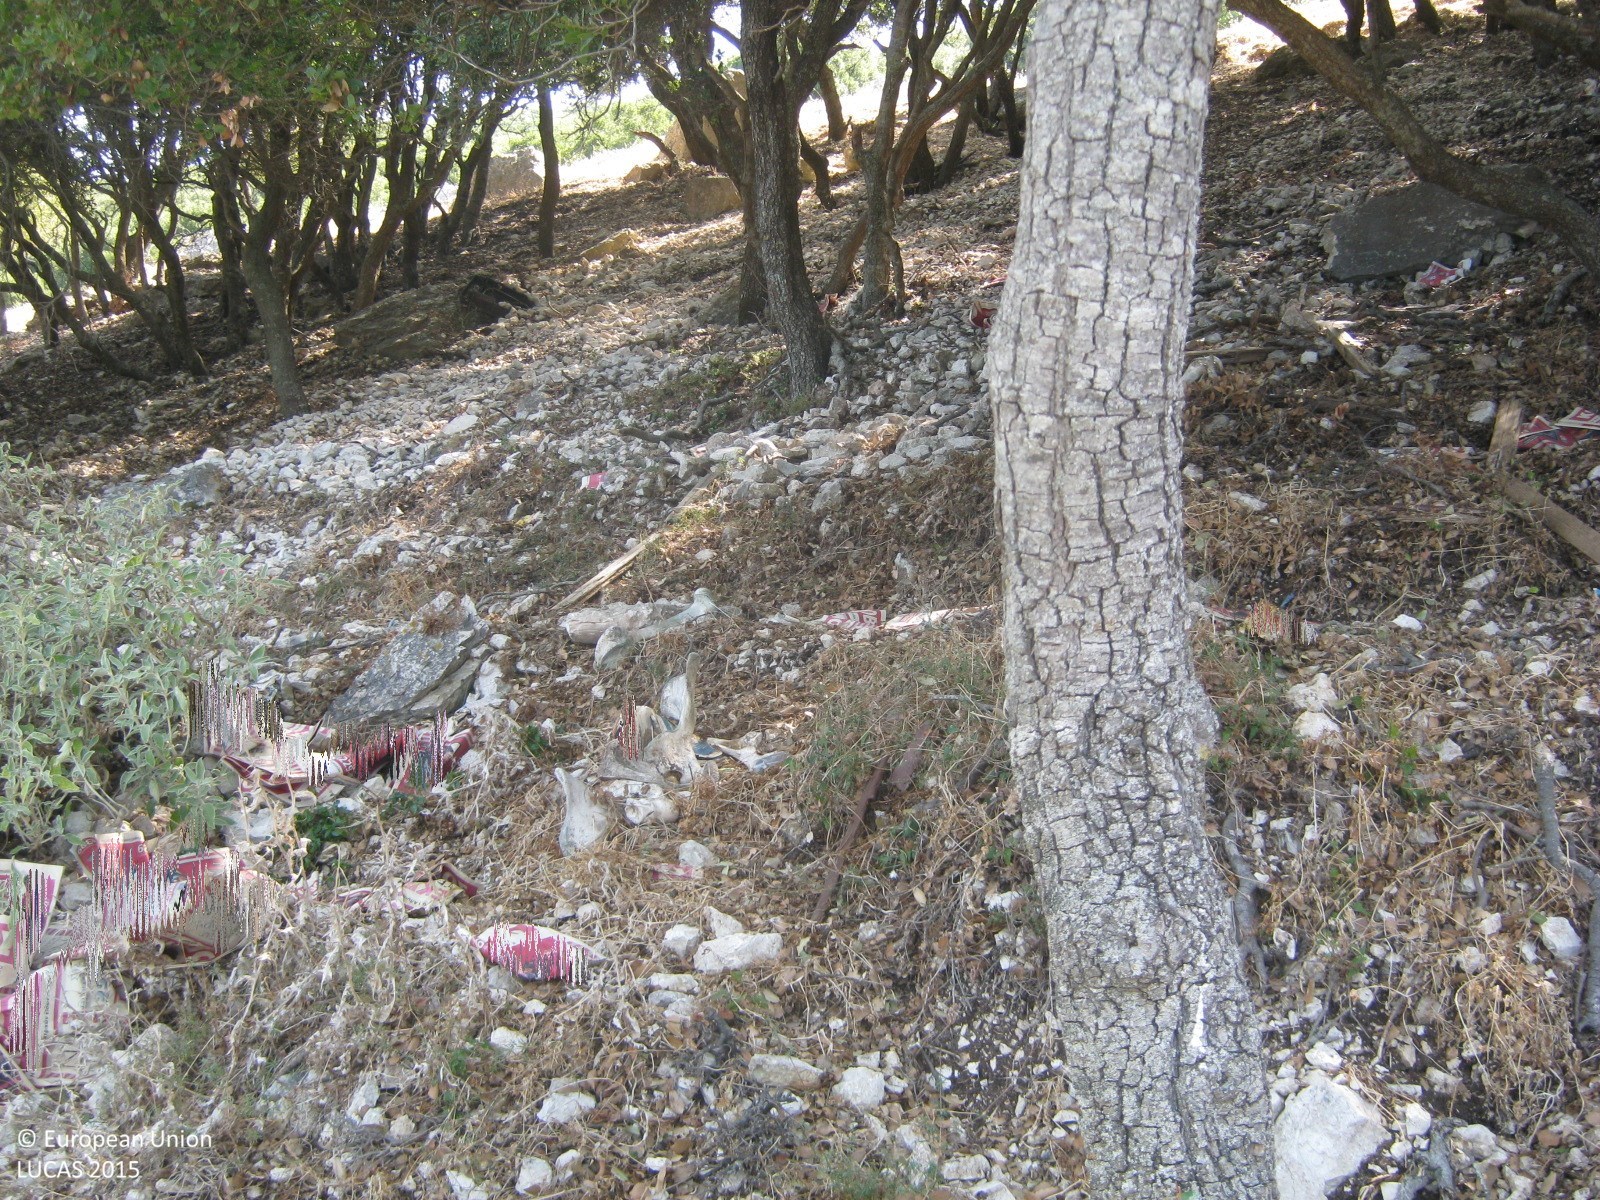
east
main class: Woodland
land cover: Broadleaved woodland
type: broadleaved evergreen forest
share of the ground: 50 - 75 %
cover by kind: broadleaved forest trees 65 %, consolidated bare surface 15 %, coniferous forest trees 10 %, shrubs 5 %, herbaceous plants 5 %
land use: Semi-natural and natural areas not in use
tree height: < 5 m
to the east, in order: Broadleaved woodland; Rocks and stones; Broadleaved woodland; Spontaneously vegetated surfaces; Paved roads, cycling and walking lanes; Rocks and stones; Electric lines; Broadleaved woodland
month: August
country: GR
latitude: 38.3315
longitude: 20.5214
